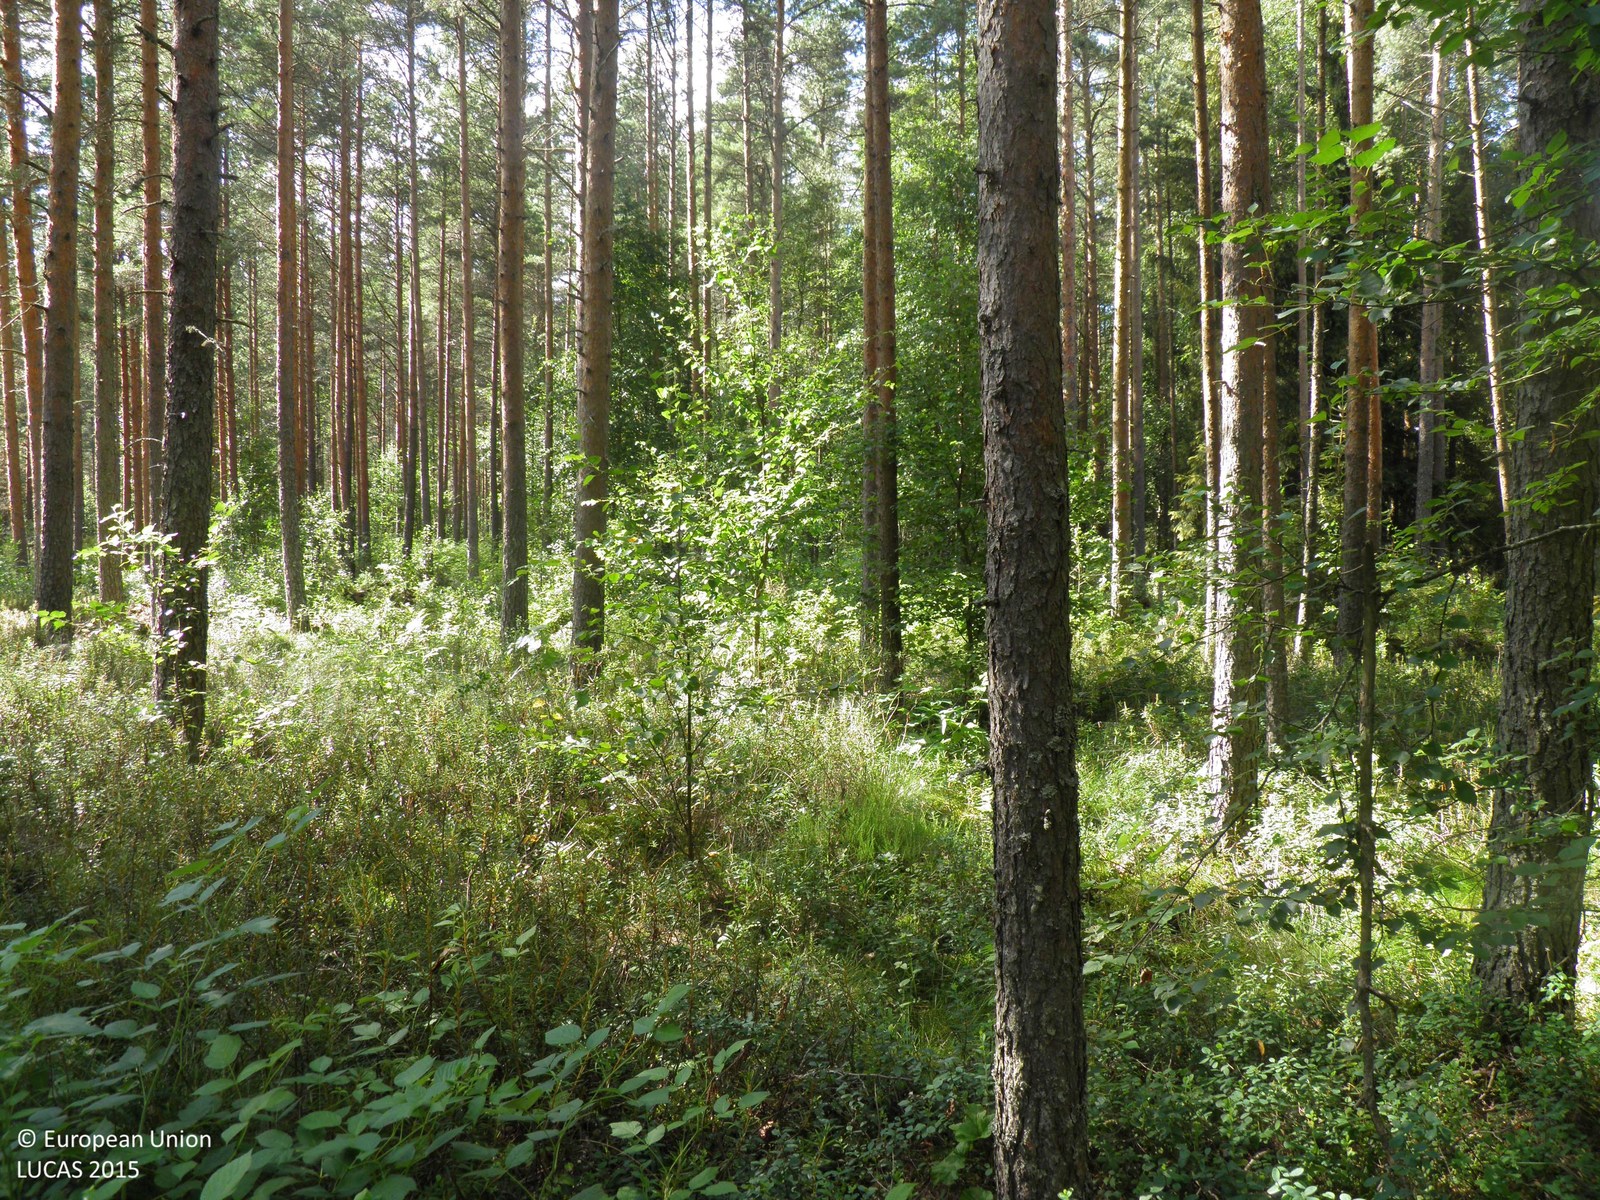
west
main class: Woodland
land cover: Pine dominated coniferous woodland
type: hemiboreal forest and nemoral coniferous forest and mixed broadleaved-coniferous forest
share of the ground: > 75 %
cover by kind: coniferous forest trees 75 %, shrubs 10 %, broadleaved forest trees 5 %, herbaceous plants 5 %, lichens and mosses 5 %
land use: Forestry
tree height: > 5 m
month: August
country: FI
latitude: 61.0099
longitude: 23.1166
